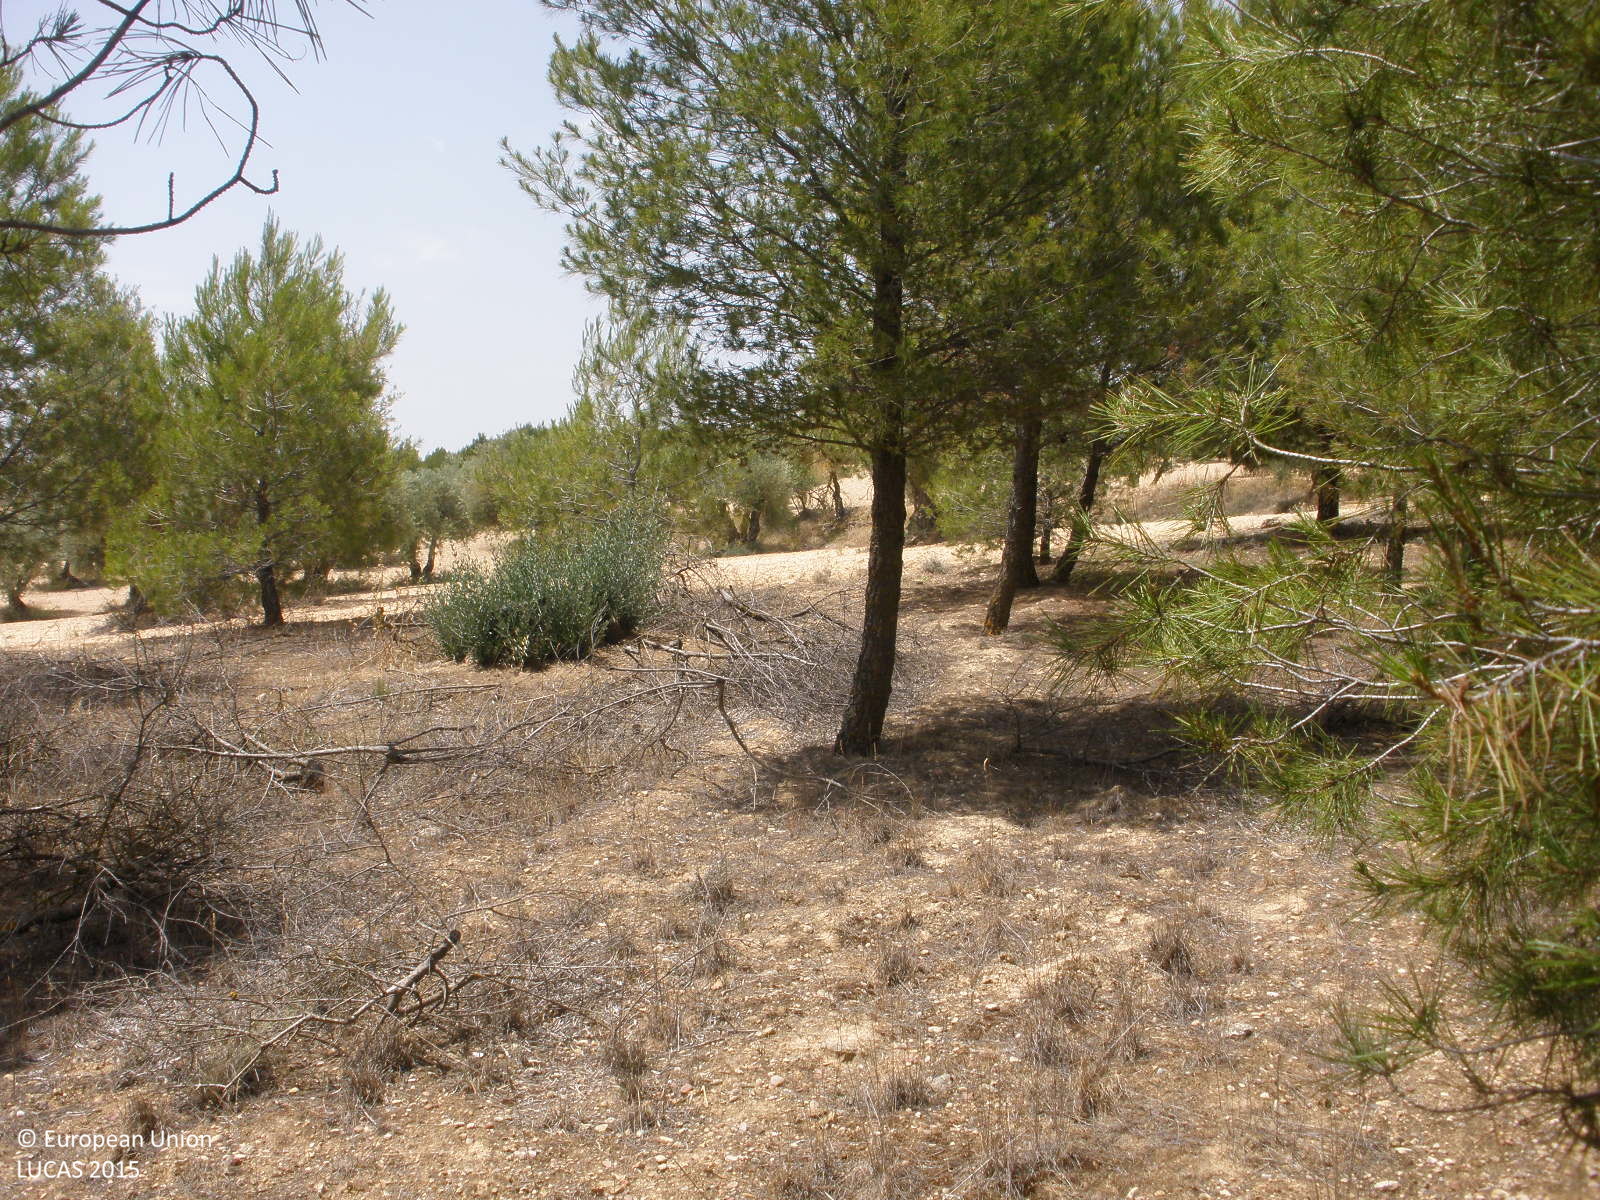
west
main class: Woodland
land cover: Pine dominated coniferous woodland
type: coniferous forest of the mediterranean region
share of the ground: 50 - 75 %
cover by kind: coniferous forest trees 70 %, herbaceous plants 20 %, consolidated bare surface 10 %
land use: Forestry
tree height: > 5 m
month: July
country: ES
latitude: 39.8194
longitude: -3.4024
